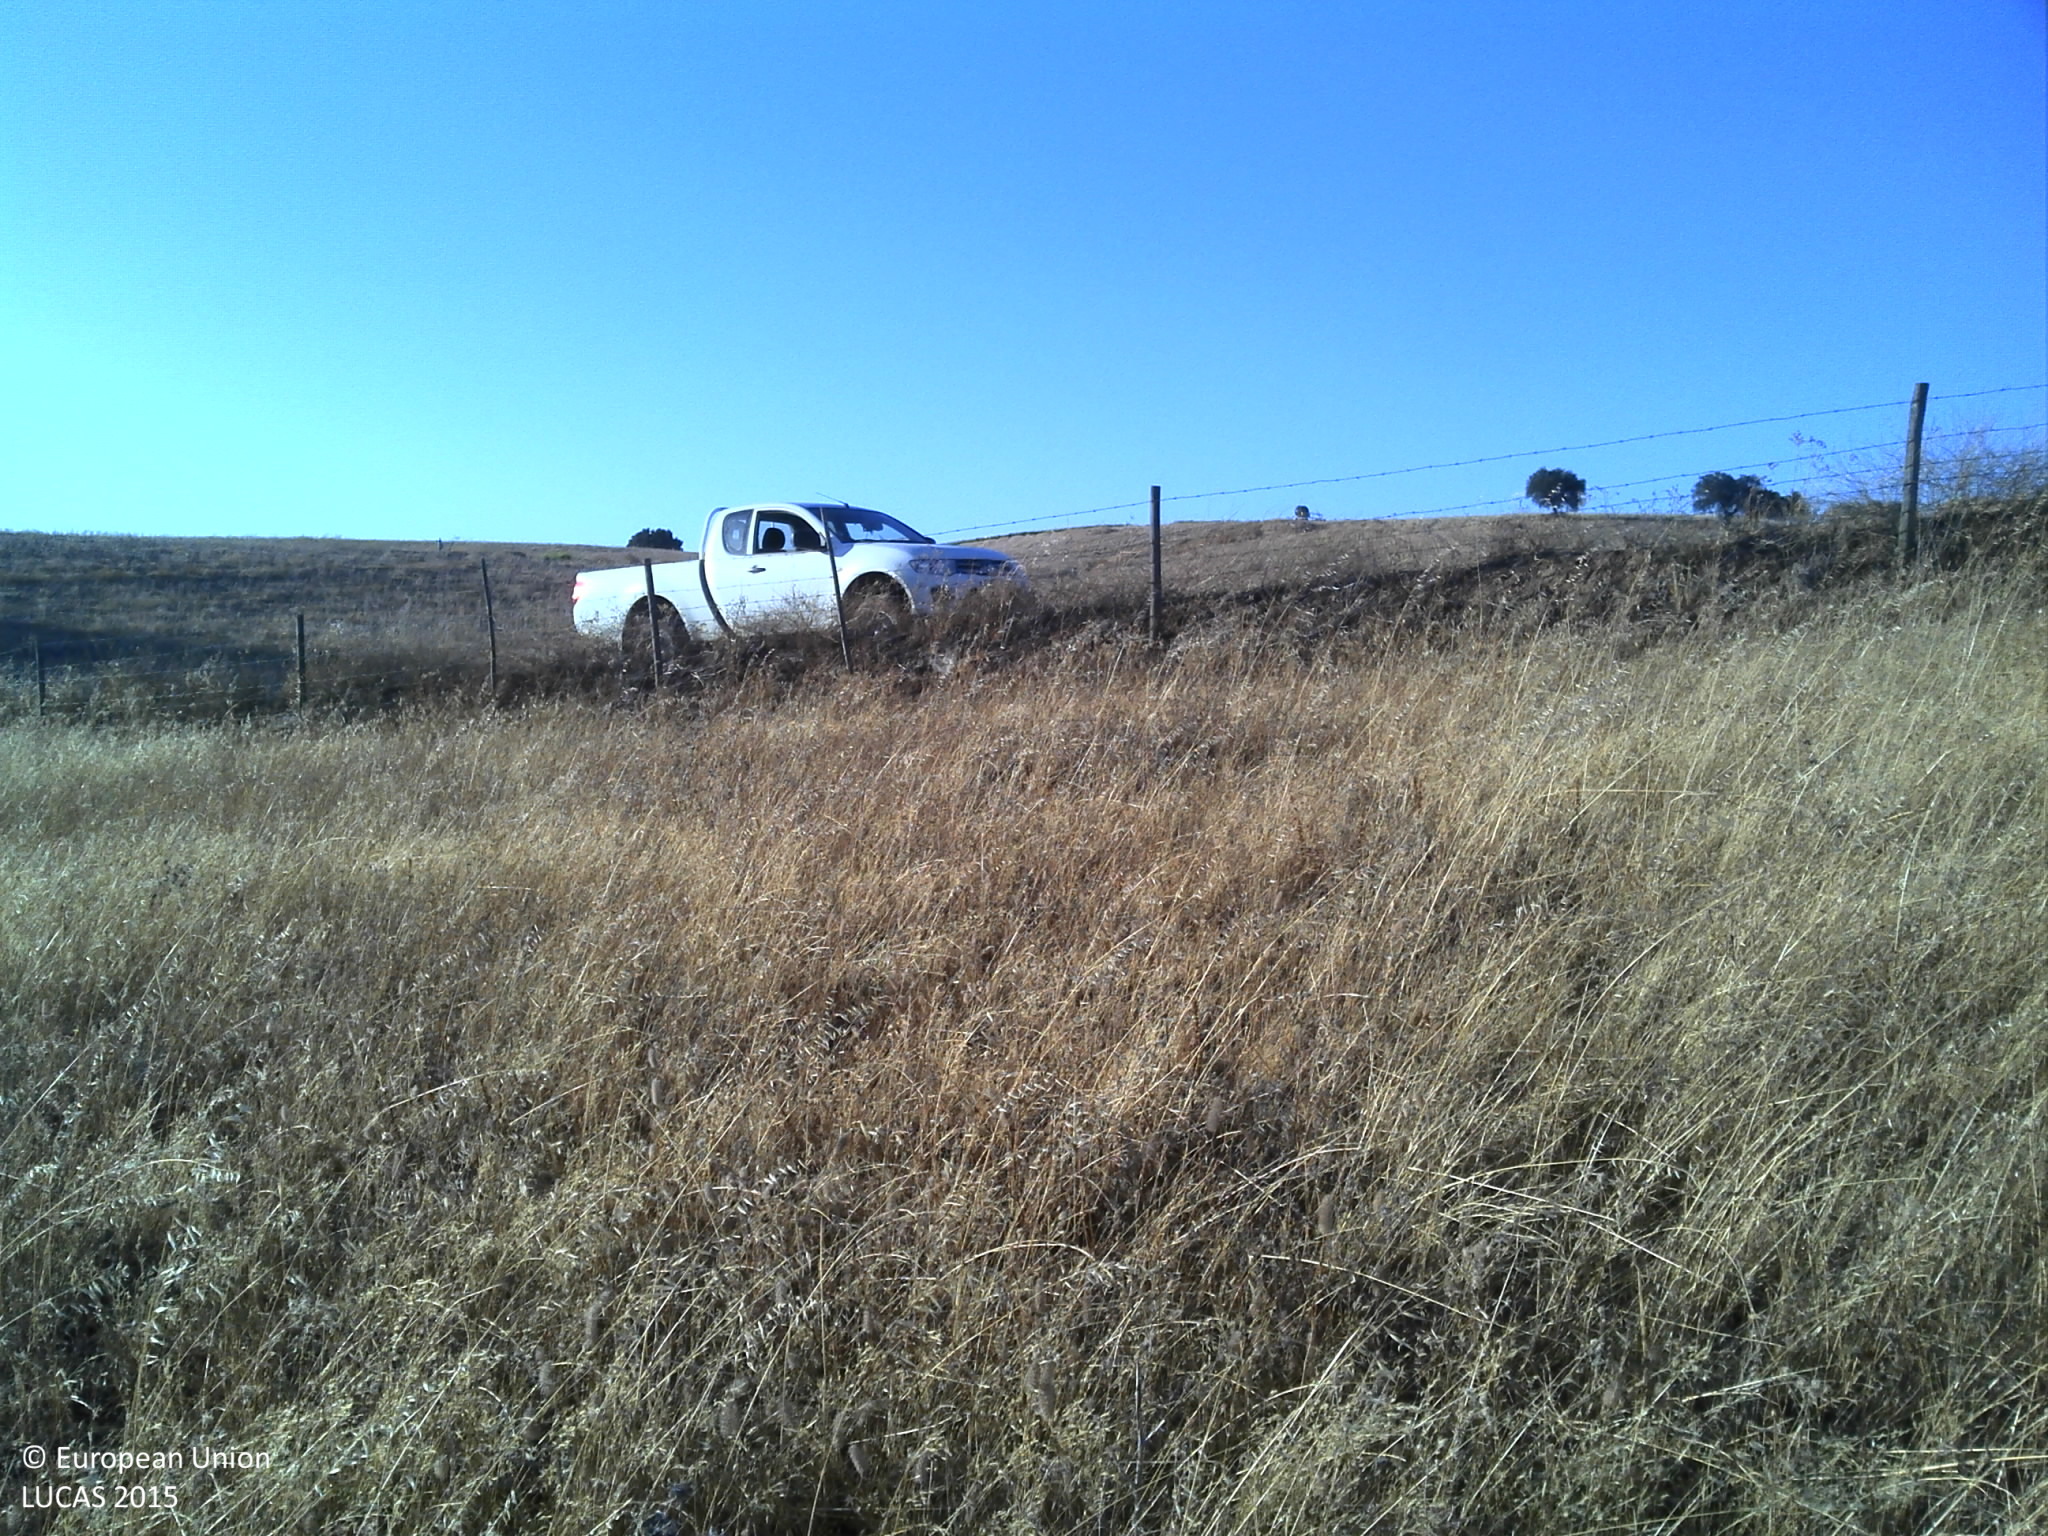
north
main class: Grassland
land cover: Grassland without tree/shrub cover
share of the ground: > 75 %
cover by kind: herbaceous plants 85 %, unconsolidated bare surface 15 %
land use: Agriculture (excluding fallow land and kitchen gardens)
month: July
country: PT
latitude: 38.1360
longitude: -7.7456
